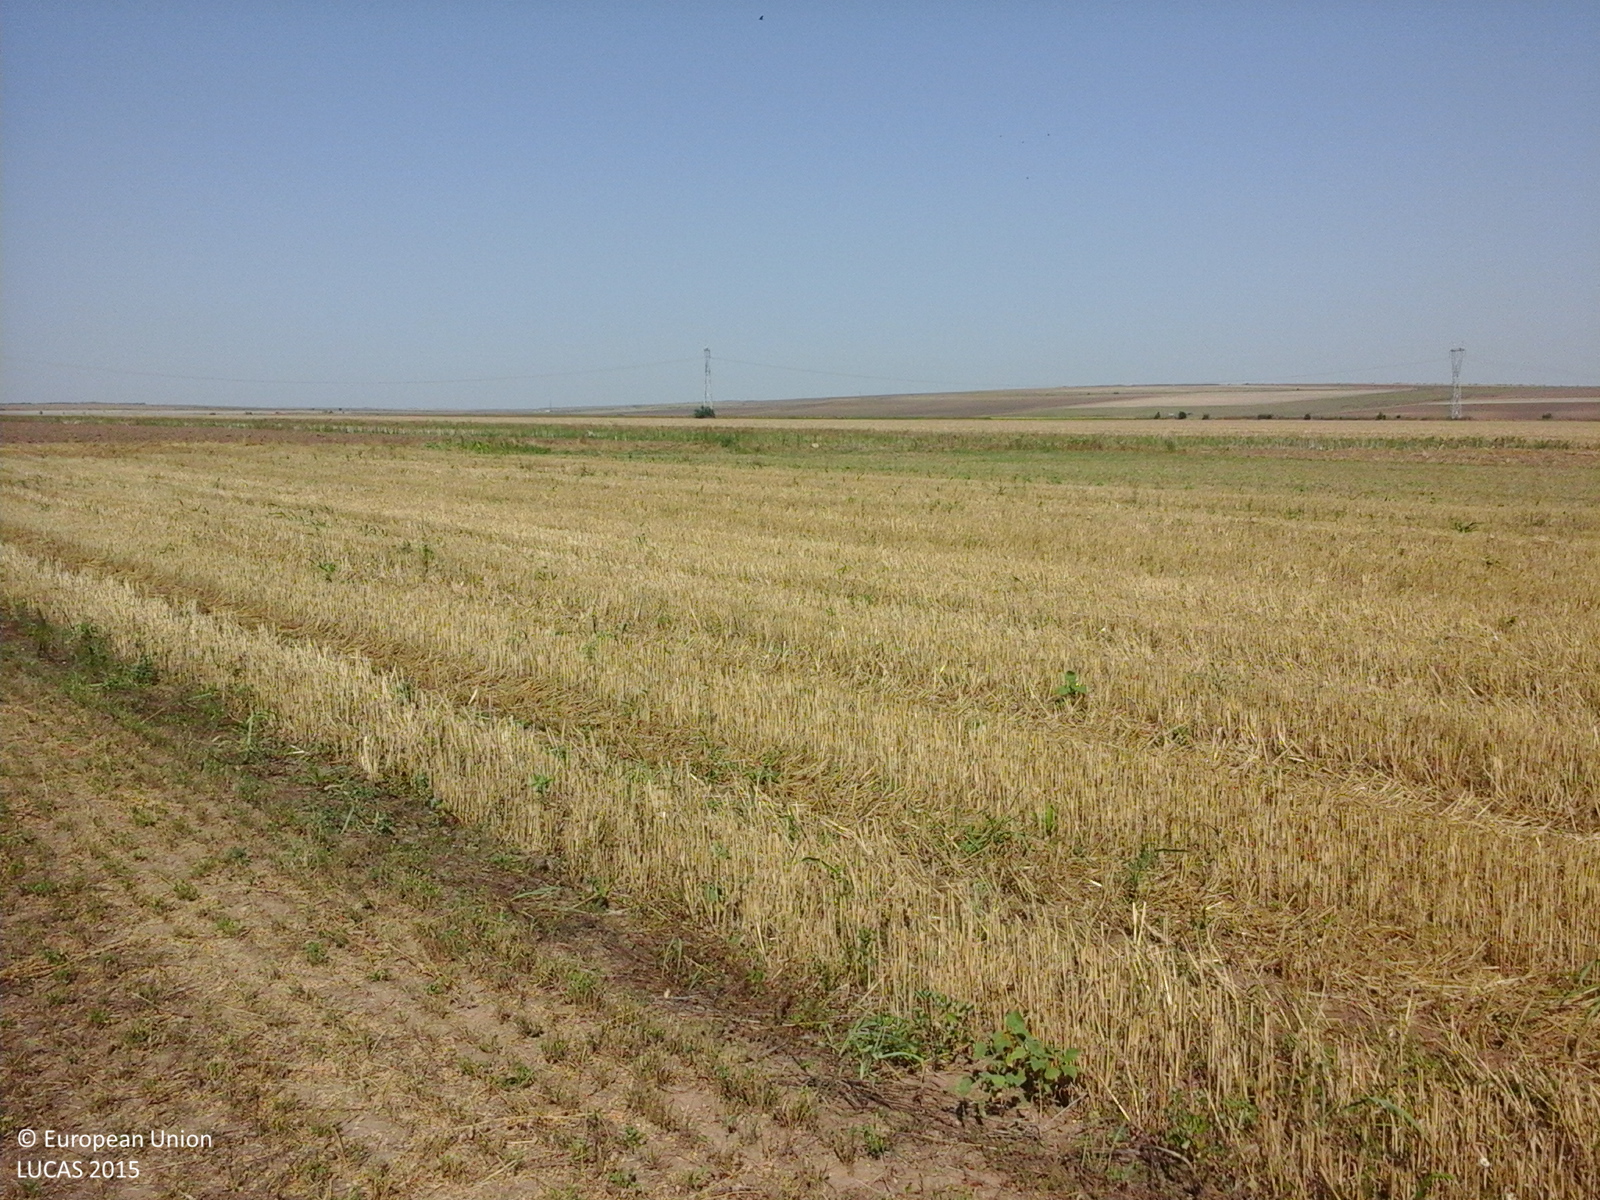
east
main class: Cropland
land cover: Lucerne
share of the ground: 10 - 25 %
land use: Agriculture (excluding fallow land and kitchen gardens)
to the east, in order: Lucerne; Common wheat; Rape and turnip rape; Common wheat
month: August
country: RO
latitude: 44.2673
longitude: 28.3429
